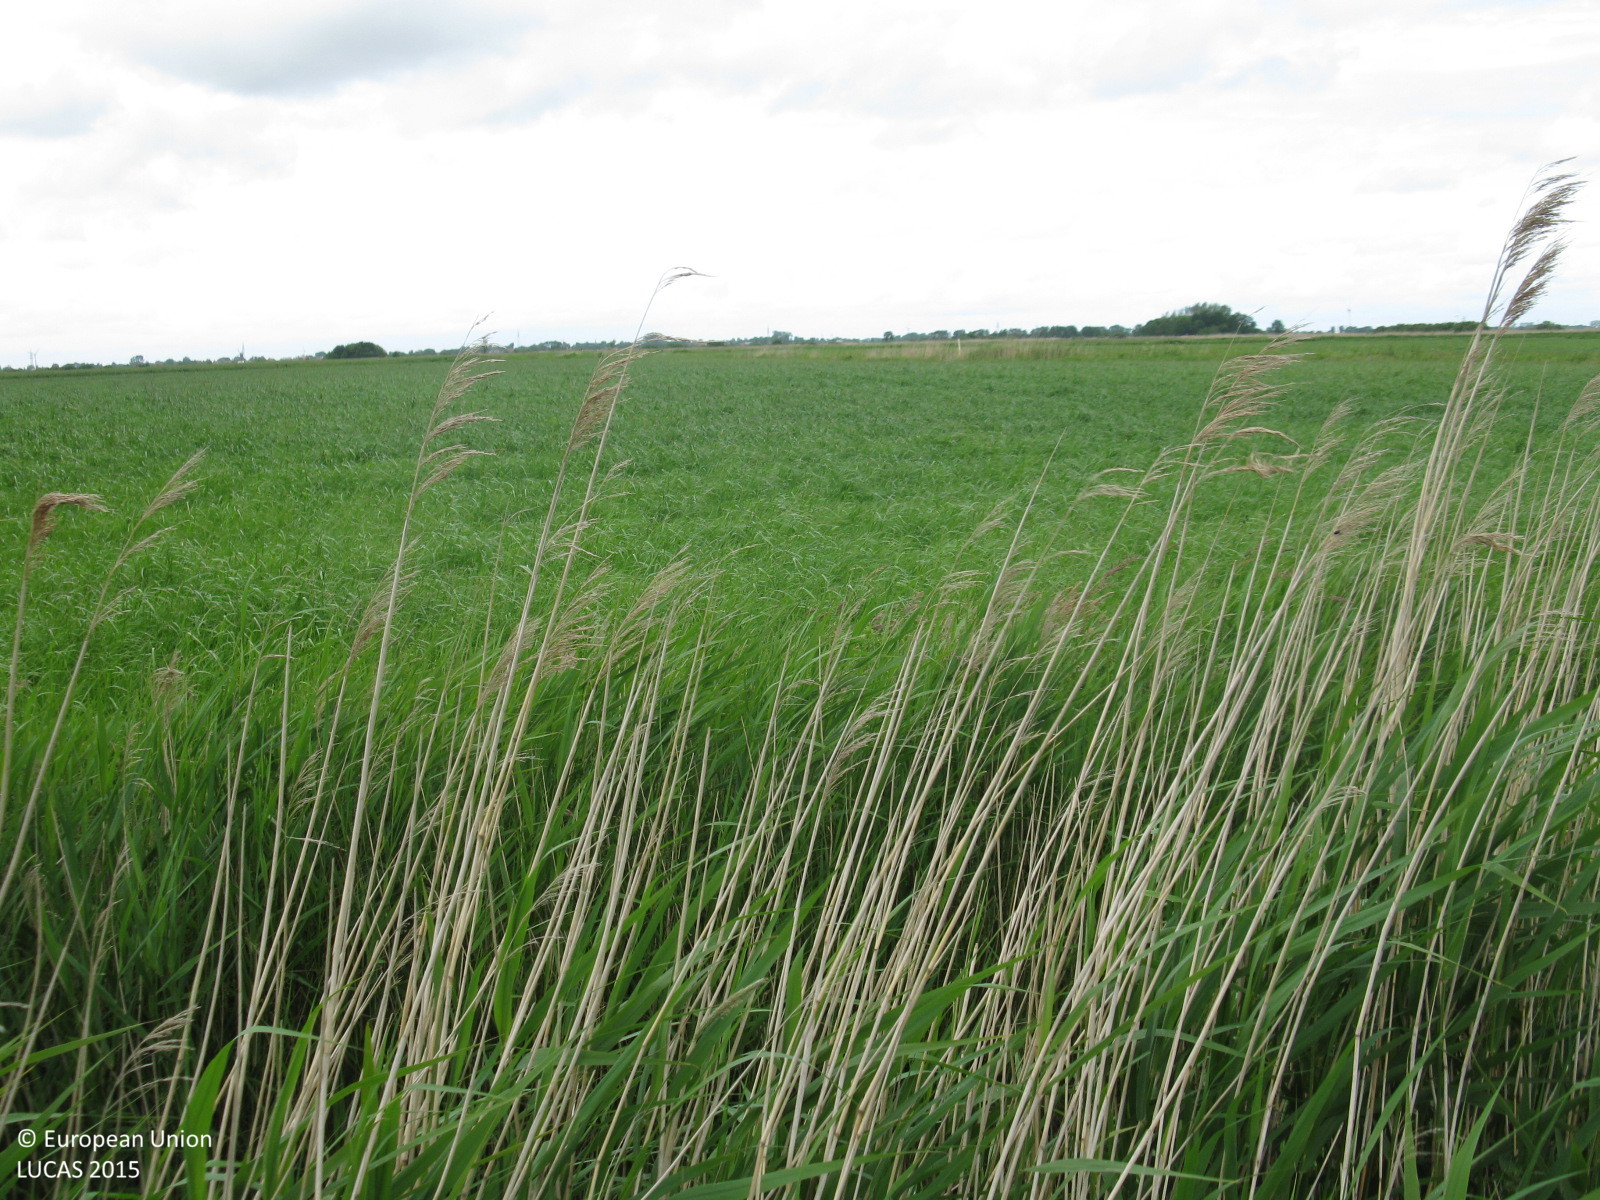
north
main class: Cropland
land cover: Temporary grasslands
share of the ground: > 75 %
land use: Agriculture (excluding fallow land and kitchen gardens)
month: June
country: DE
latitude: 53.6255
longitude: 7.3849
